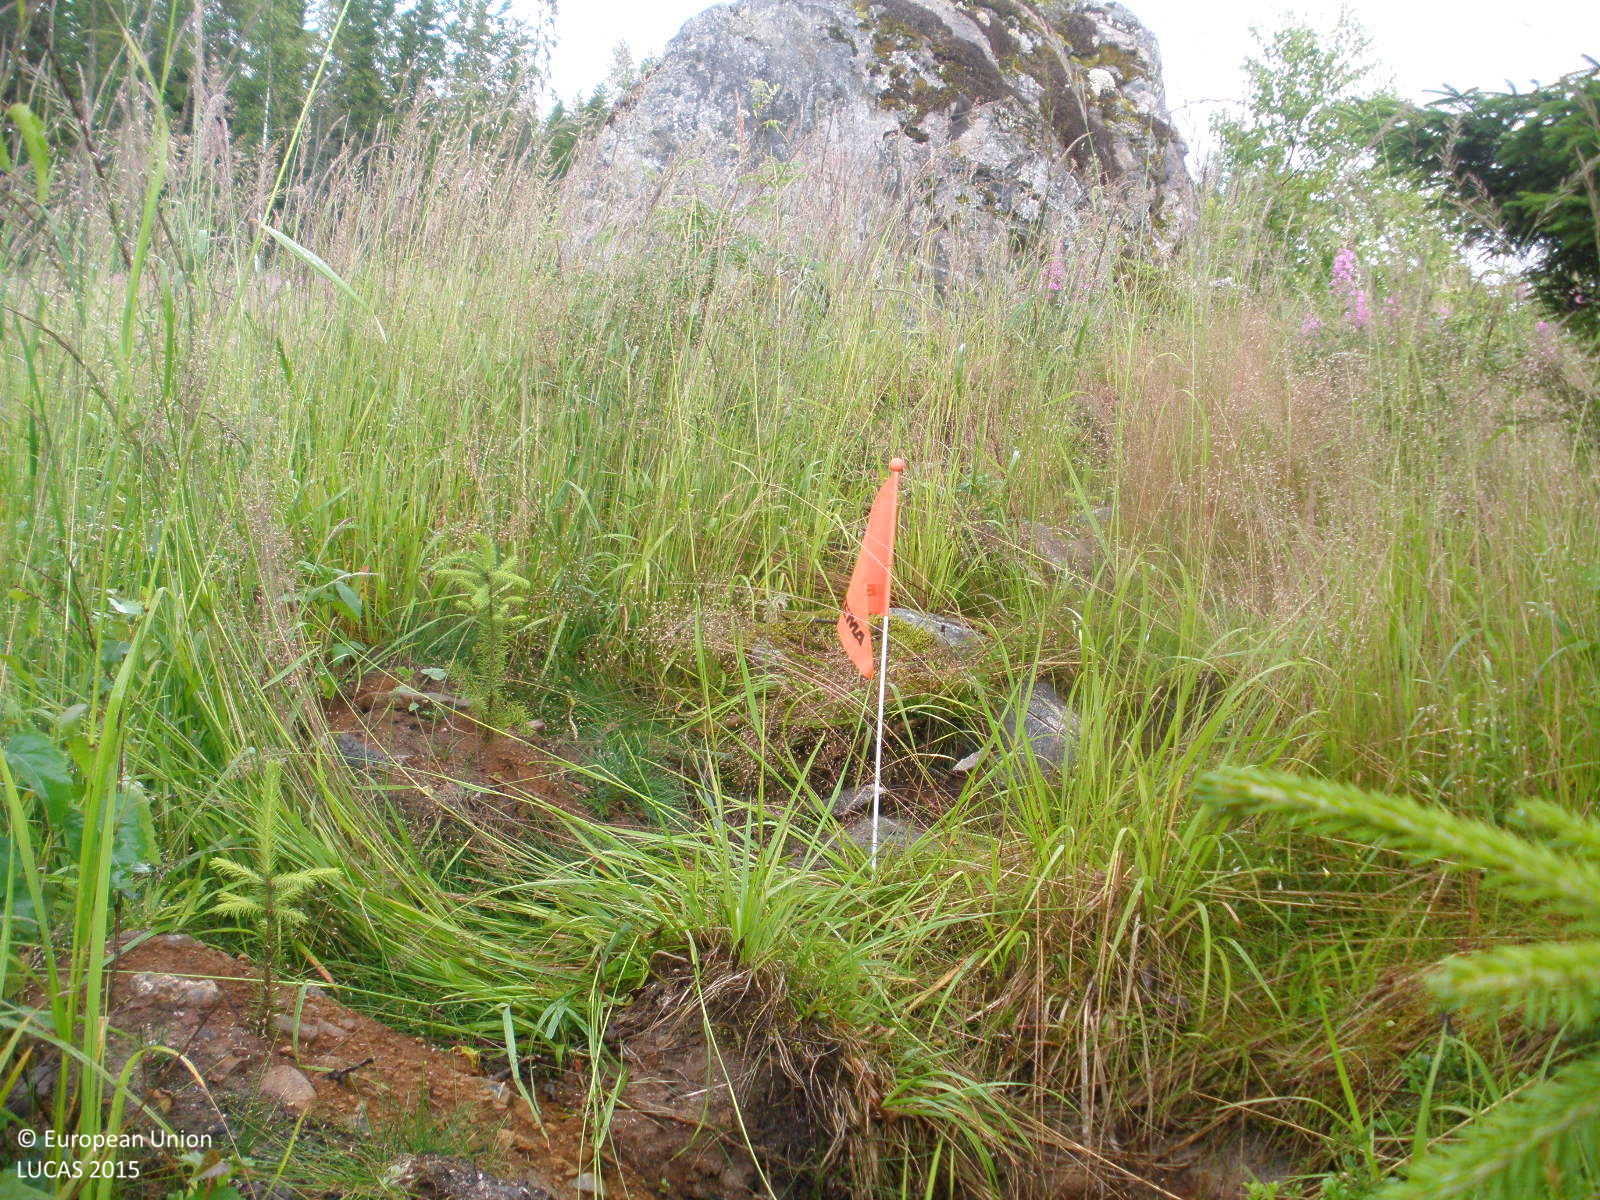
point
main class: Woodland
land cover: Other mixed woodland
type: boreal forest
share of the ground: 10 - 25 %
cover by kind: herbaceous plants 60 %, lichens and mosses 15 %, shrubs 10 %, coniferous forest trees 5 %, broadleaved forest trees 5 %, unconsolidated bare surface 5 %
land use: Forestry
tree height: < 5 m
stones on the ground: > 50 %
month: July
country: FI
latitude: 61.4564
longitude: 24.7563
